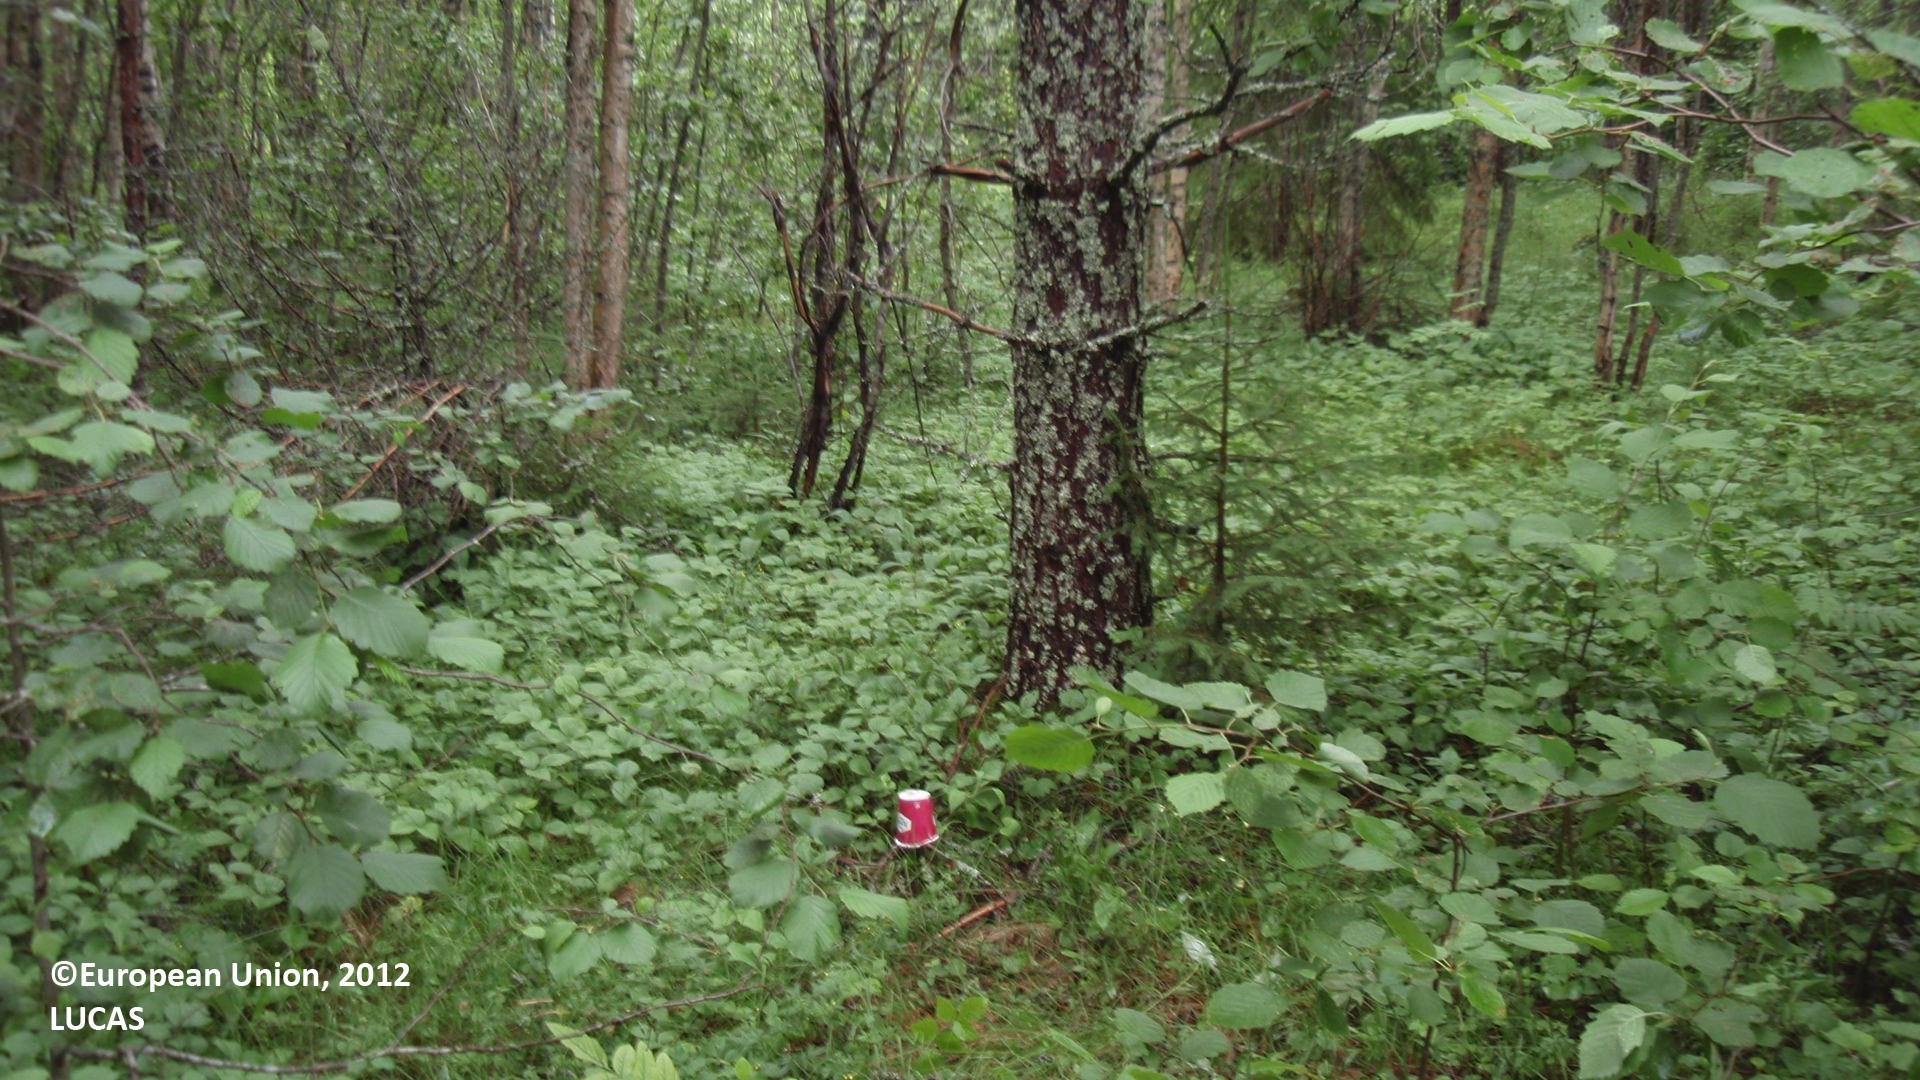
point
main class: Woodland
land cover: Pine dominated mixed woodland
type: boreal forest
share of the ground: > 75 %
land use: Forestry
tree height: > 5 m
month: July
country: FI
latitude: 61.4763
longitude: 26.9237
